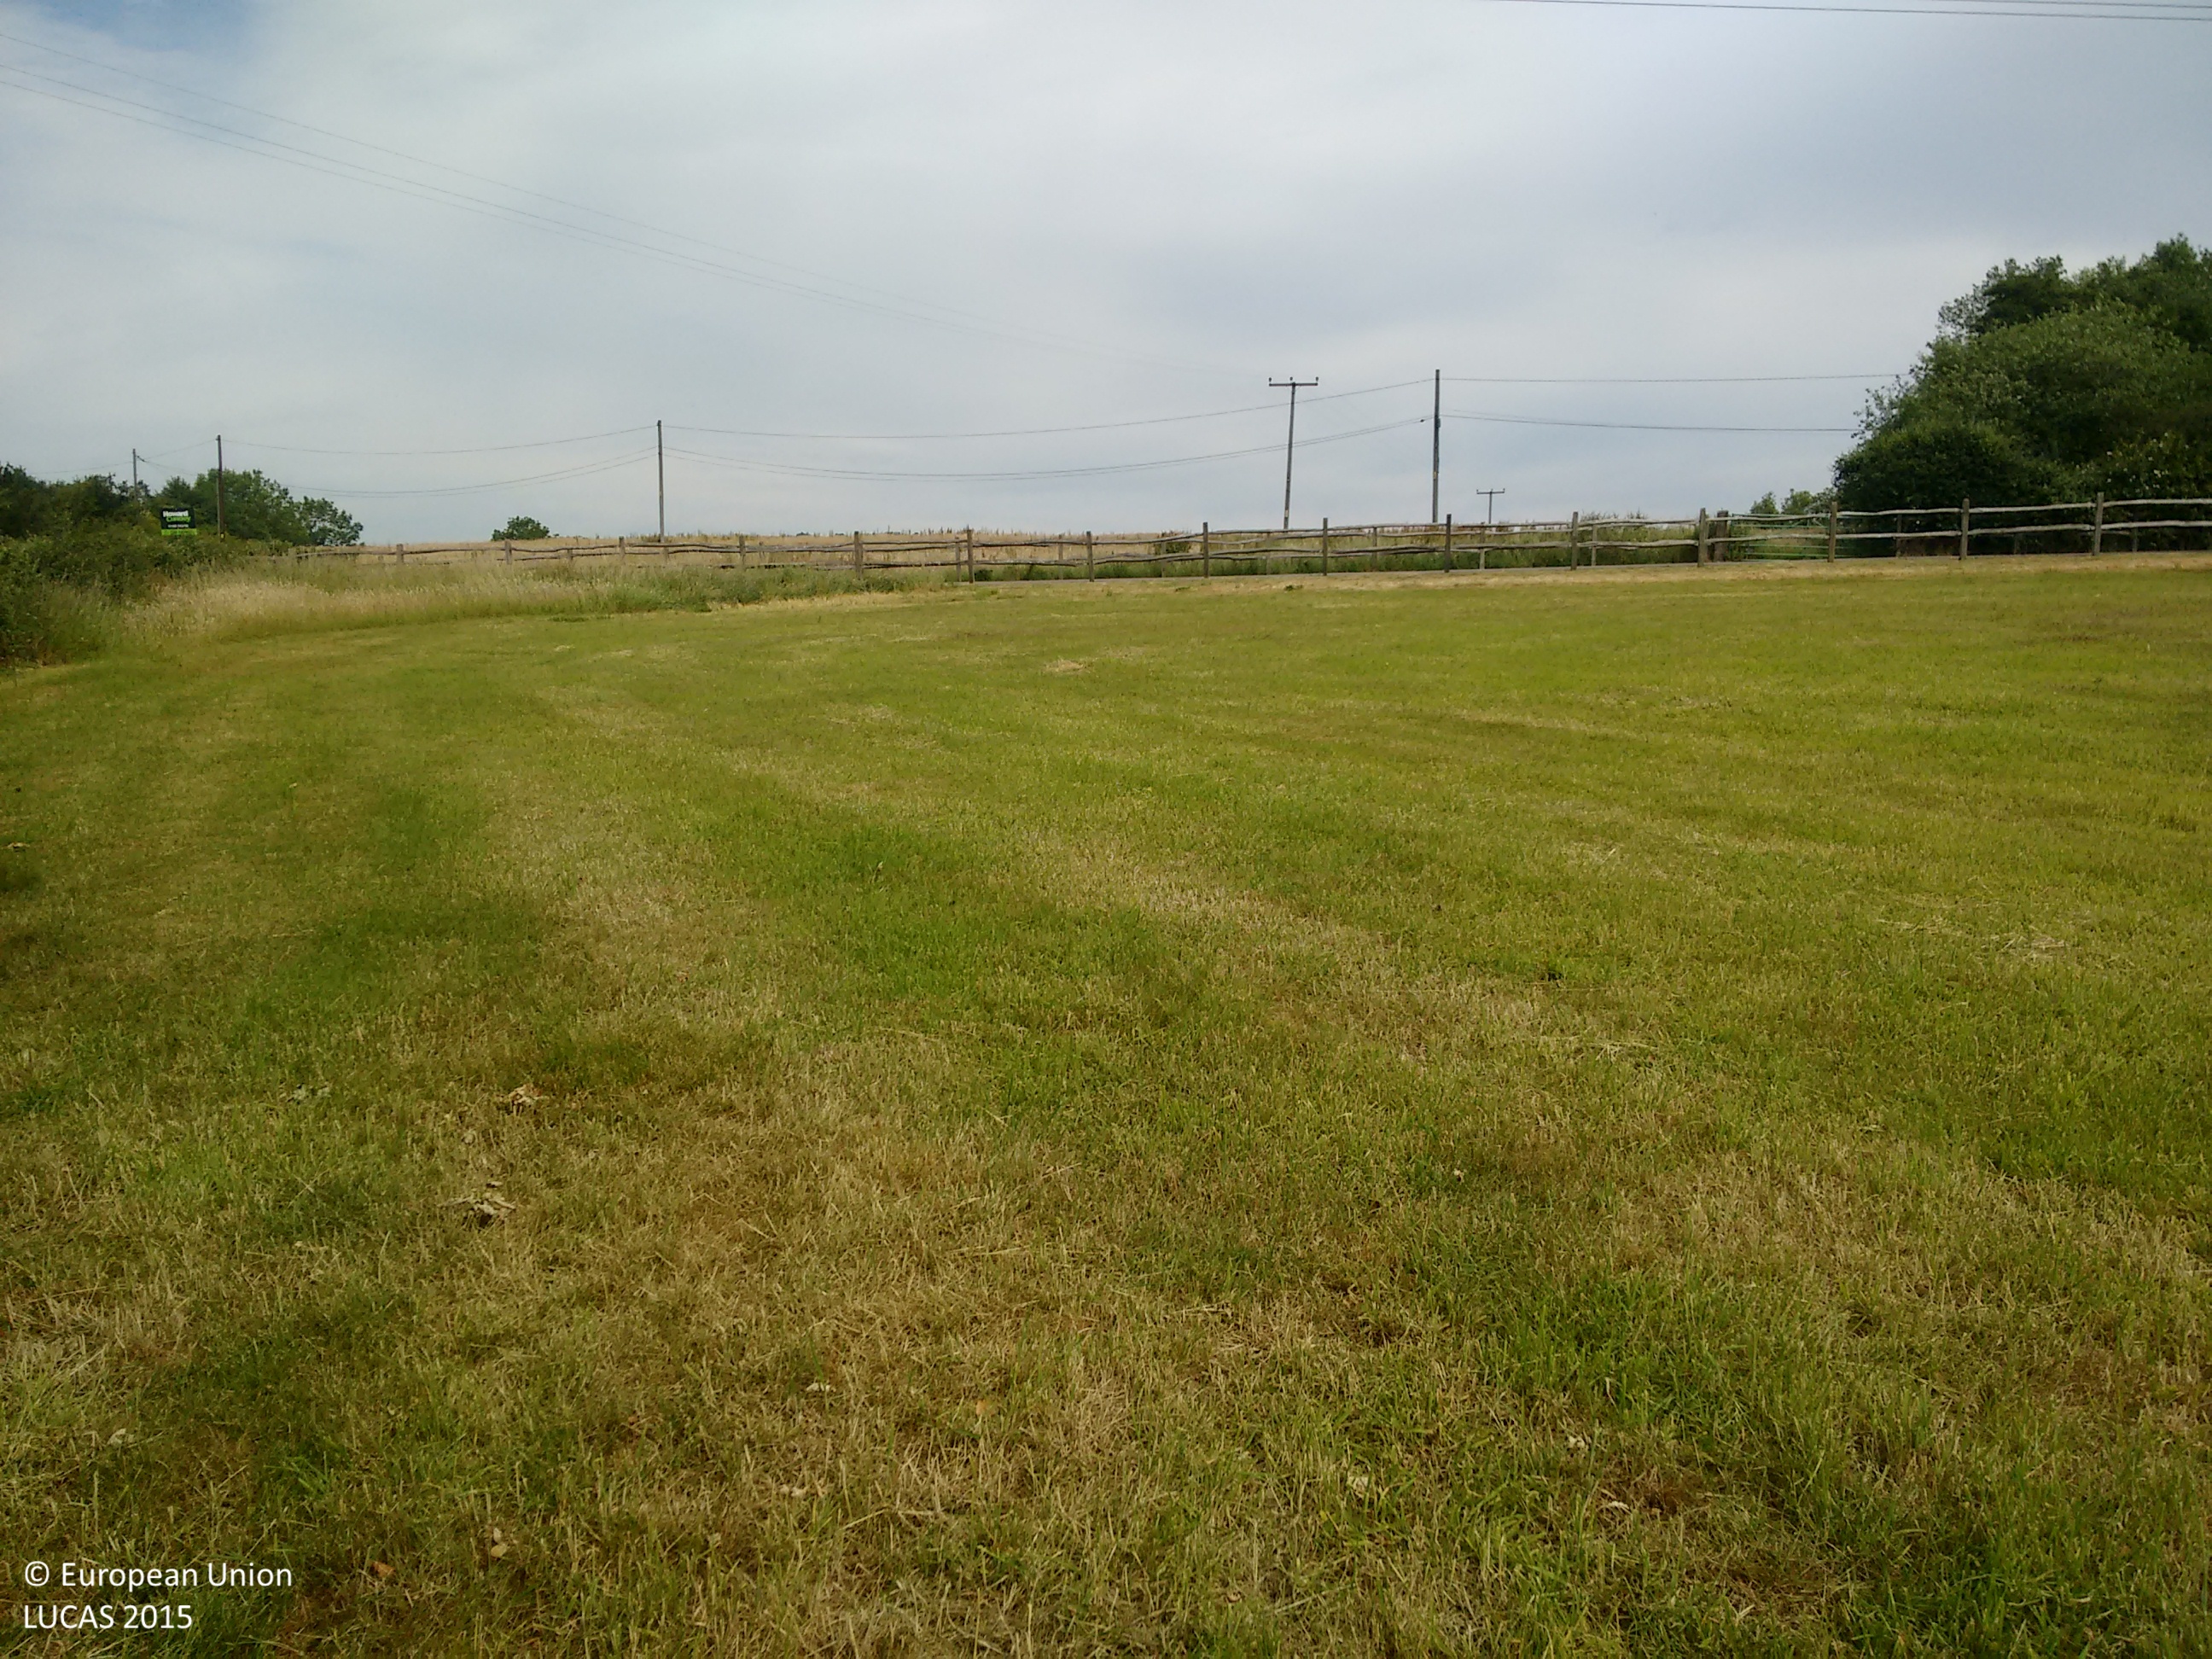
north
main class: Grassland
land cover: Grassland without tree/shrub cover
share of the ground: > 75 %
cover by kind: herbaceous plants 100 %
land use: Agriculture (excluding fallow land and kitchen gardens)
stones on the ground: < 10 %
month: June
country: GB
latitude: 51.2208
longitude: -0.0994
